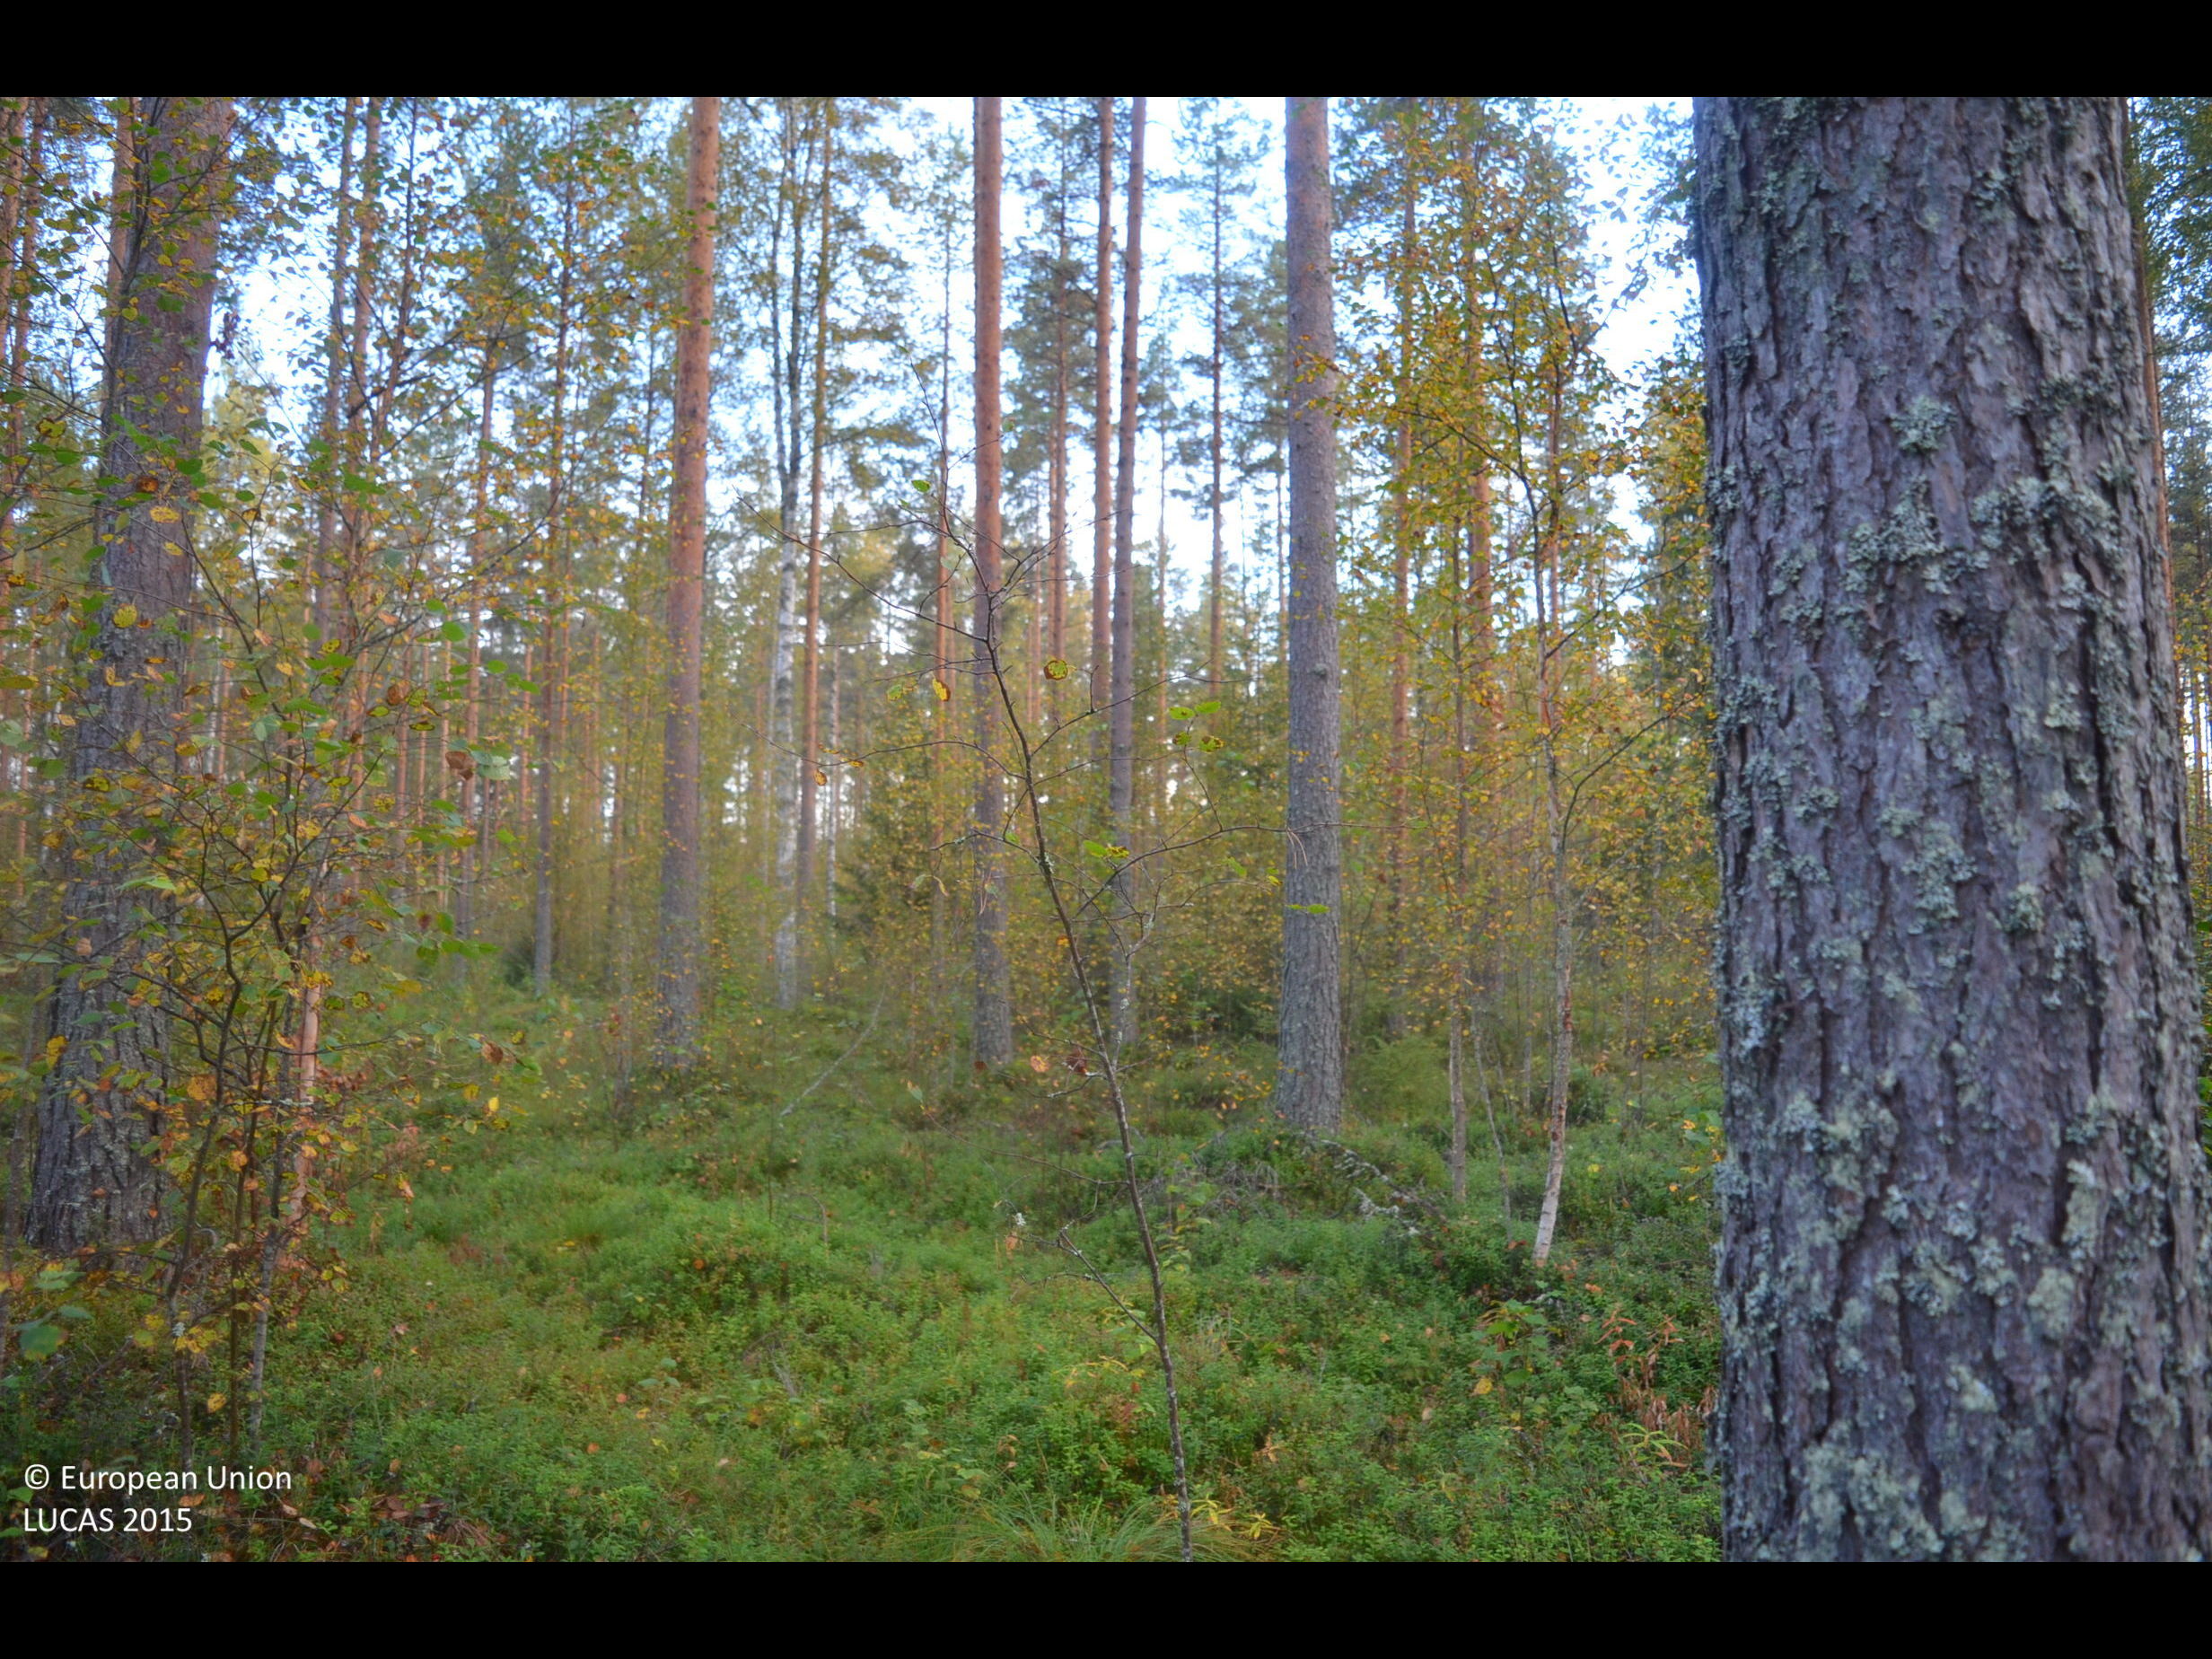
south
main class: Woodland
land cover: Pine dominated mixed woodland
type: boreal forest
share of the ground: 50 - 75 %
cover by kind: coniferous forest trees 40 %, shrubs 35 %, broadleaved forest trees 25 %
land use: Forestry
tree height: > 5 m
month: September
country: FI
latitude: 62.9665
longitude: 23.7778
